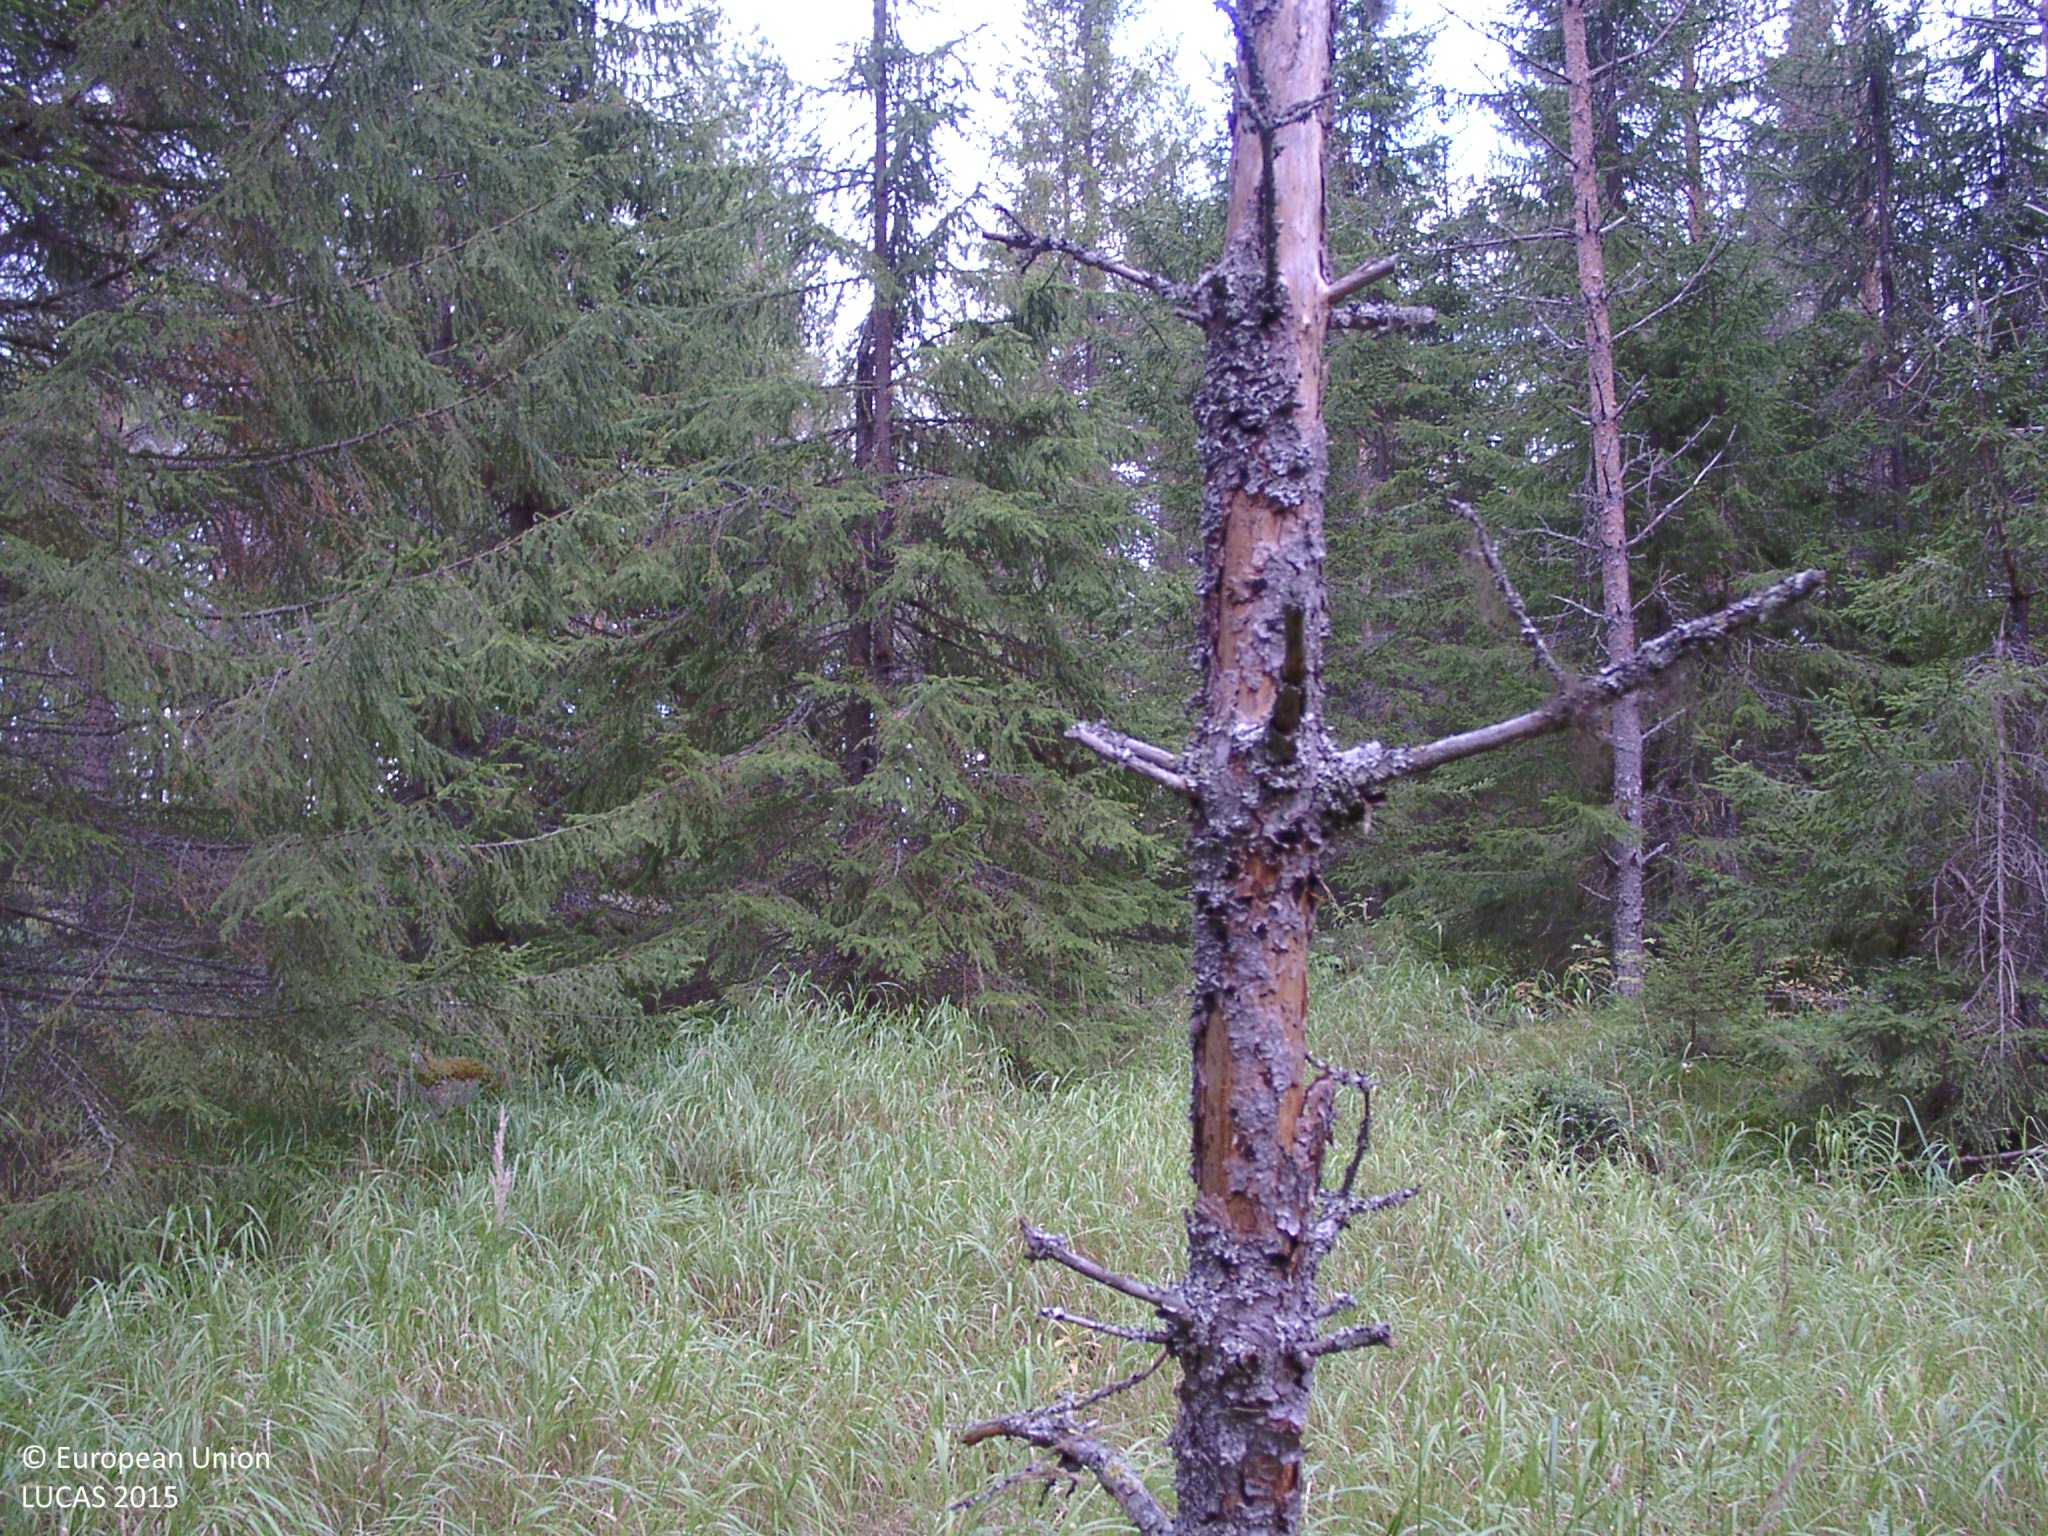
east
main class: Woodland
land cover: Other coniferous woodland
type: boreal forest
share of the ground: 50 - 75 %
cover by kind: coniferous forest trees 50 %, herbaceous plants 30 %, shrubs 10 %, lichens and mosses 10 %
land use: Forestry
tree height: > 5 m
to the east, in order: Other coniferous woodland; Pine dominated coniferous woodland; Other mixed woodland; Ponds and wetlands; Rivers and streams; Other mixed woodland; Shrubland without tree cover
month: September
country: FI
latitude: 62.8820
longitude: 25.5859
